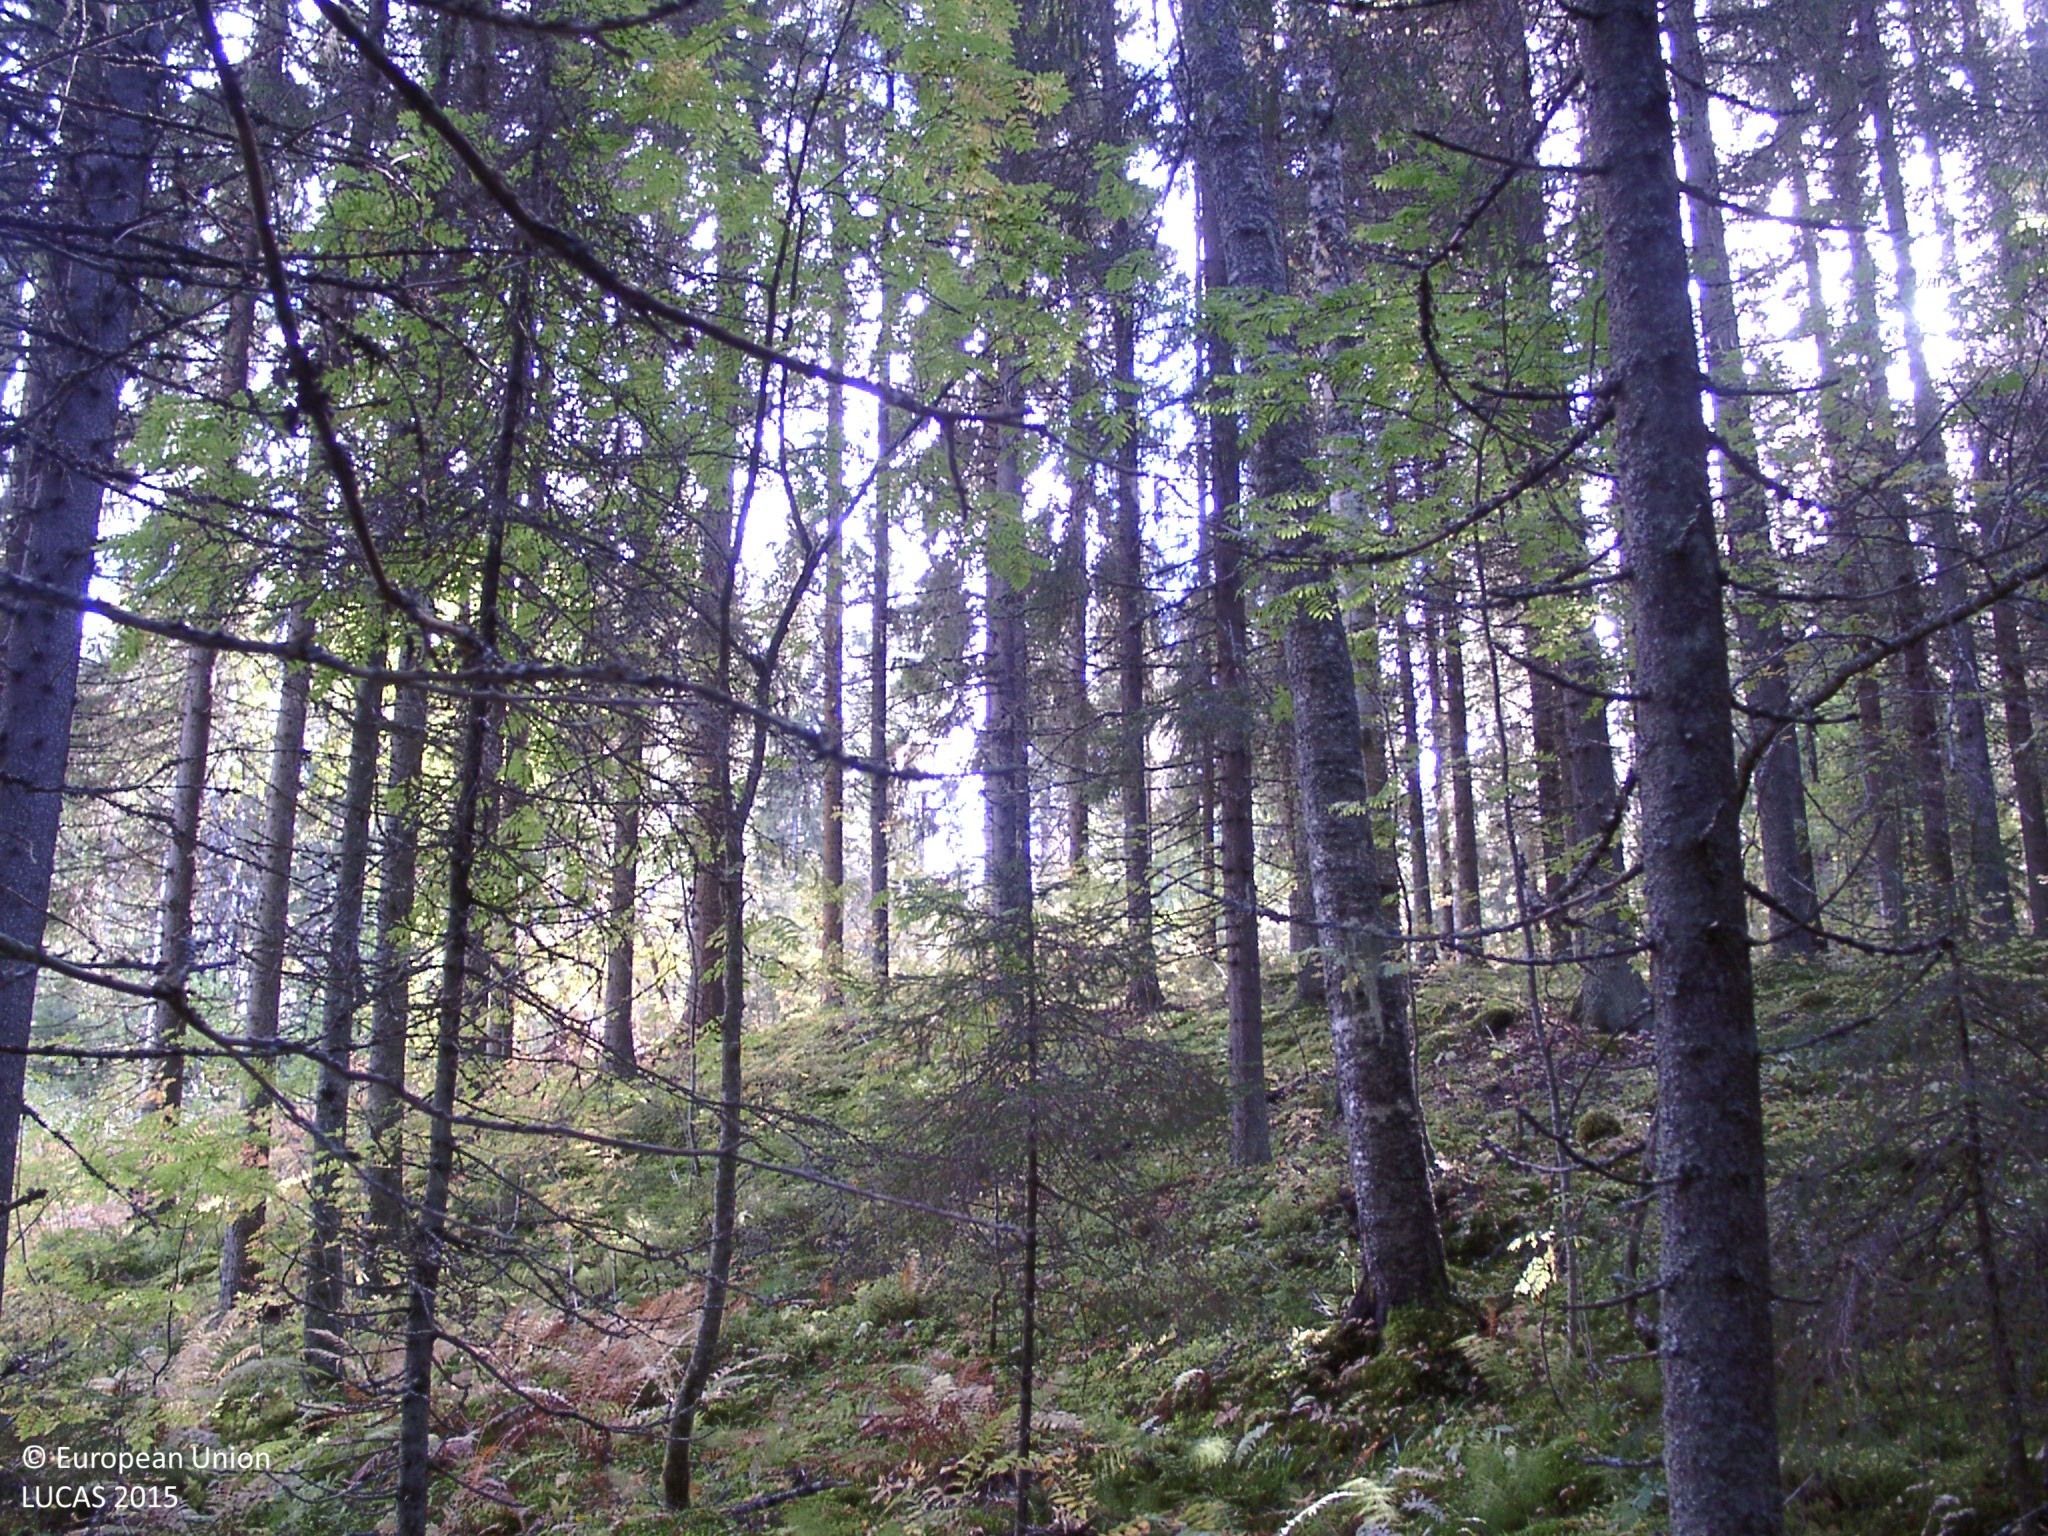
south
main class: Woodland
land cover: Spruce dominated coniferous woodland
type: boreal forest
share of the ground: > 75 %
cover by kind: coniferous forest trees 80 %, broadleaved forest trees 5 %, shrubs 5 %, herbaceous plants 5 %, lichens and mosses 5 %
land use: Forestry
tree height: > 5 m
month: September
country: FI
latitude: 62.5397
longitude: 25.3275
